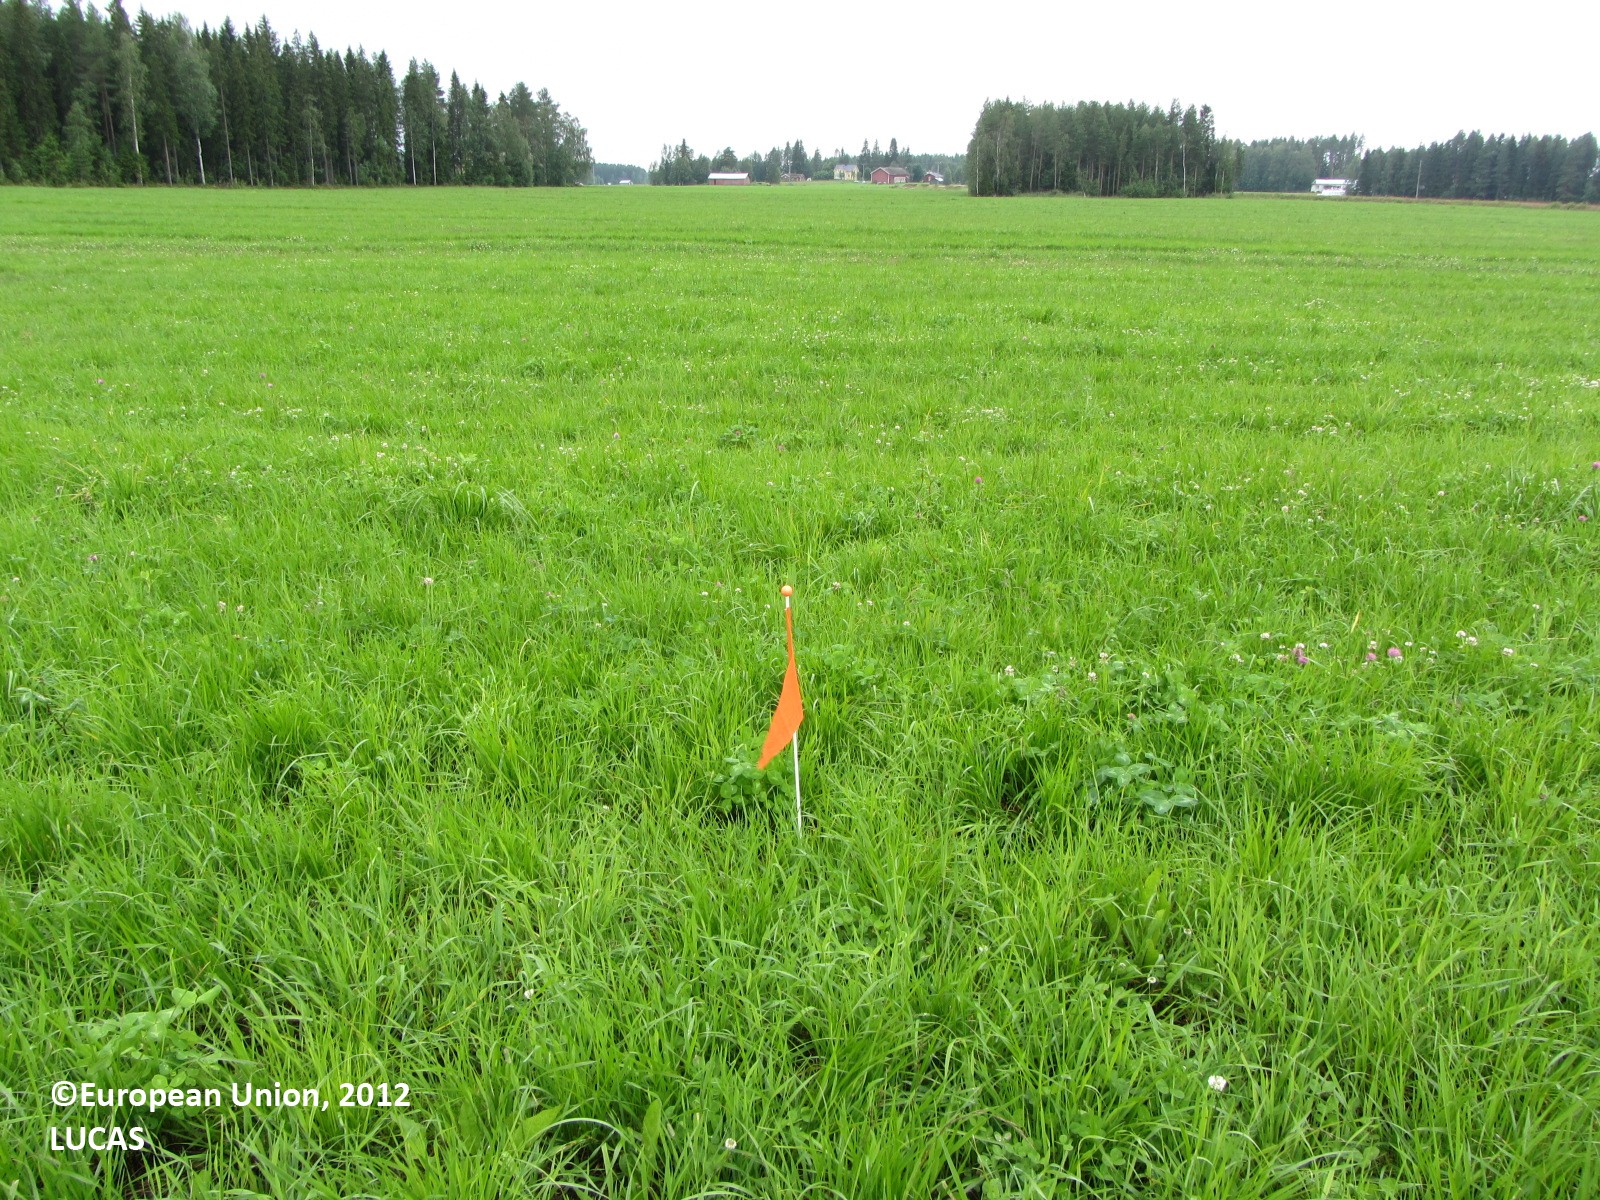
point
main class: Cropland
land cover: Temporary grasslands
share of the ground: > 75 %
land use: Agriculture (excluding fallow land and kitchen gardens)
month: July
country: FI
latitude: 63.9219
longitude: 24.7815
